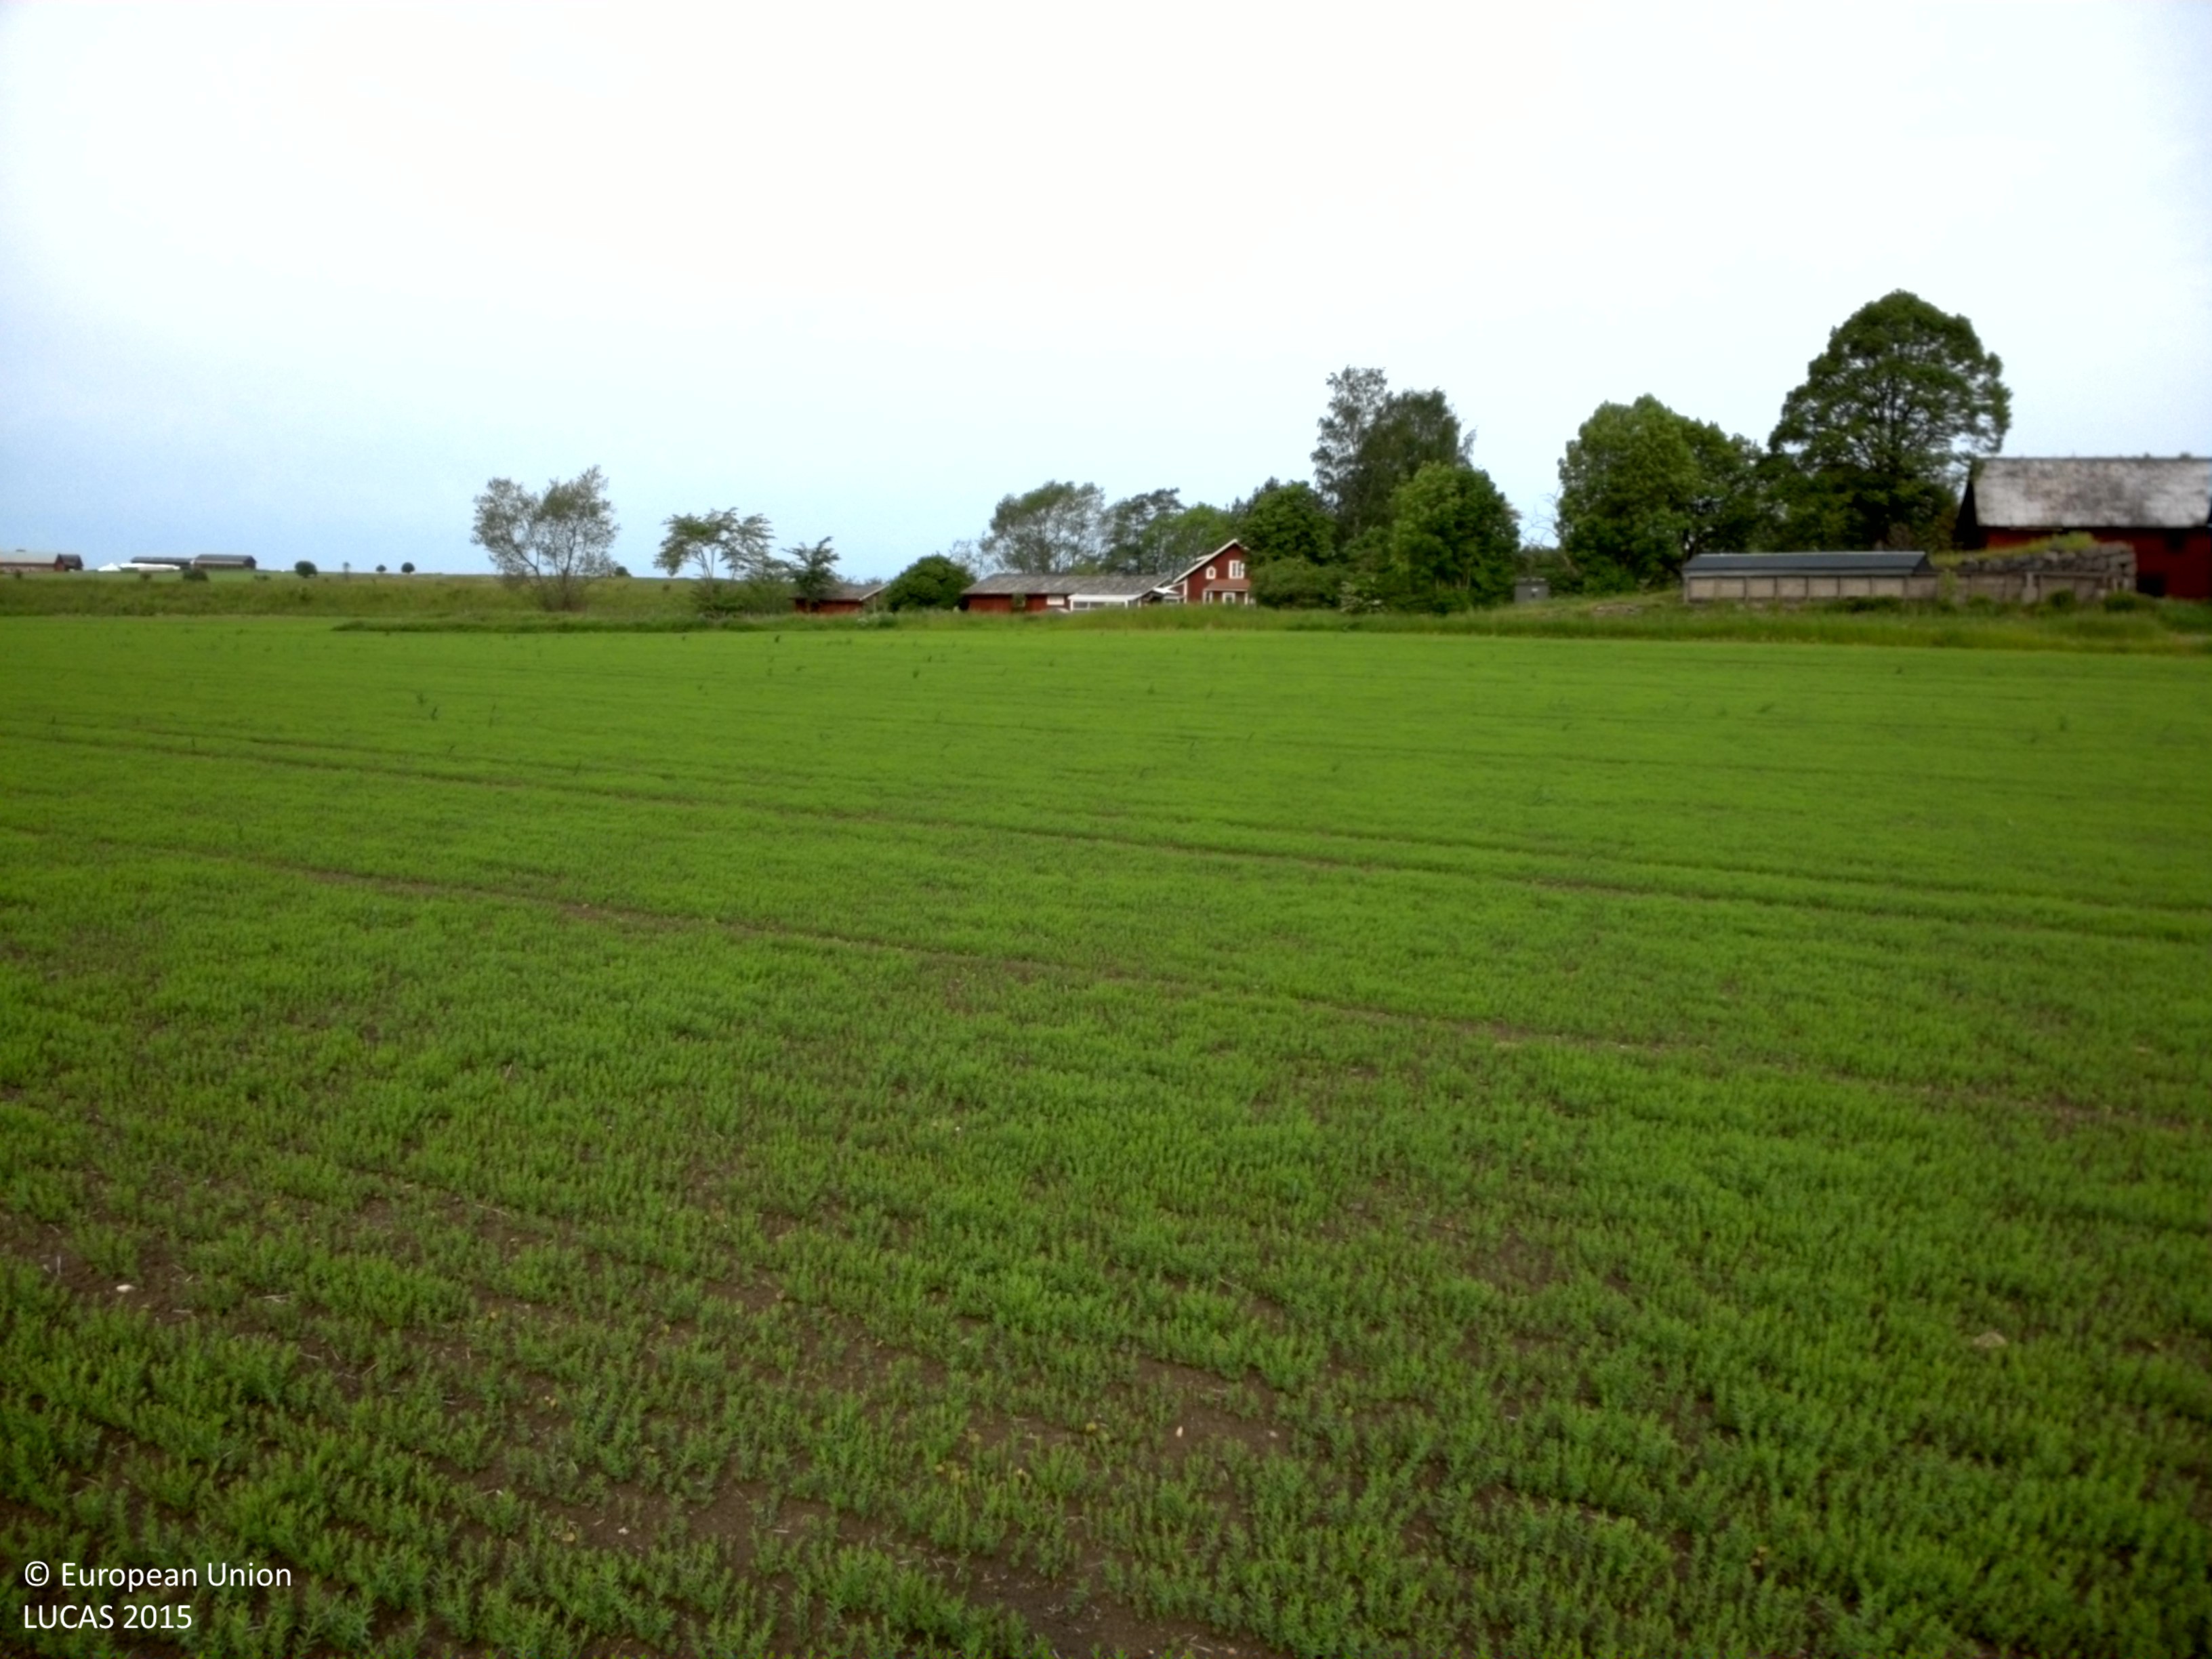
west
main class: Cropland
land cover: Other fibre and oleaginous crops
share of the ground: 10 - 25 %
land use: Agriculture (excluding fallow land and kitchen gardens)
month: June
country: SE
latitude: 58.4678
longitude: 15.4973
